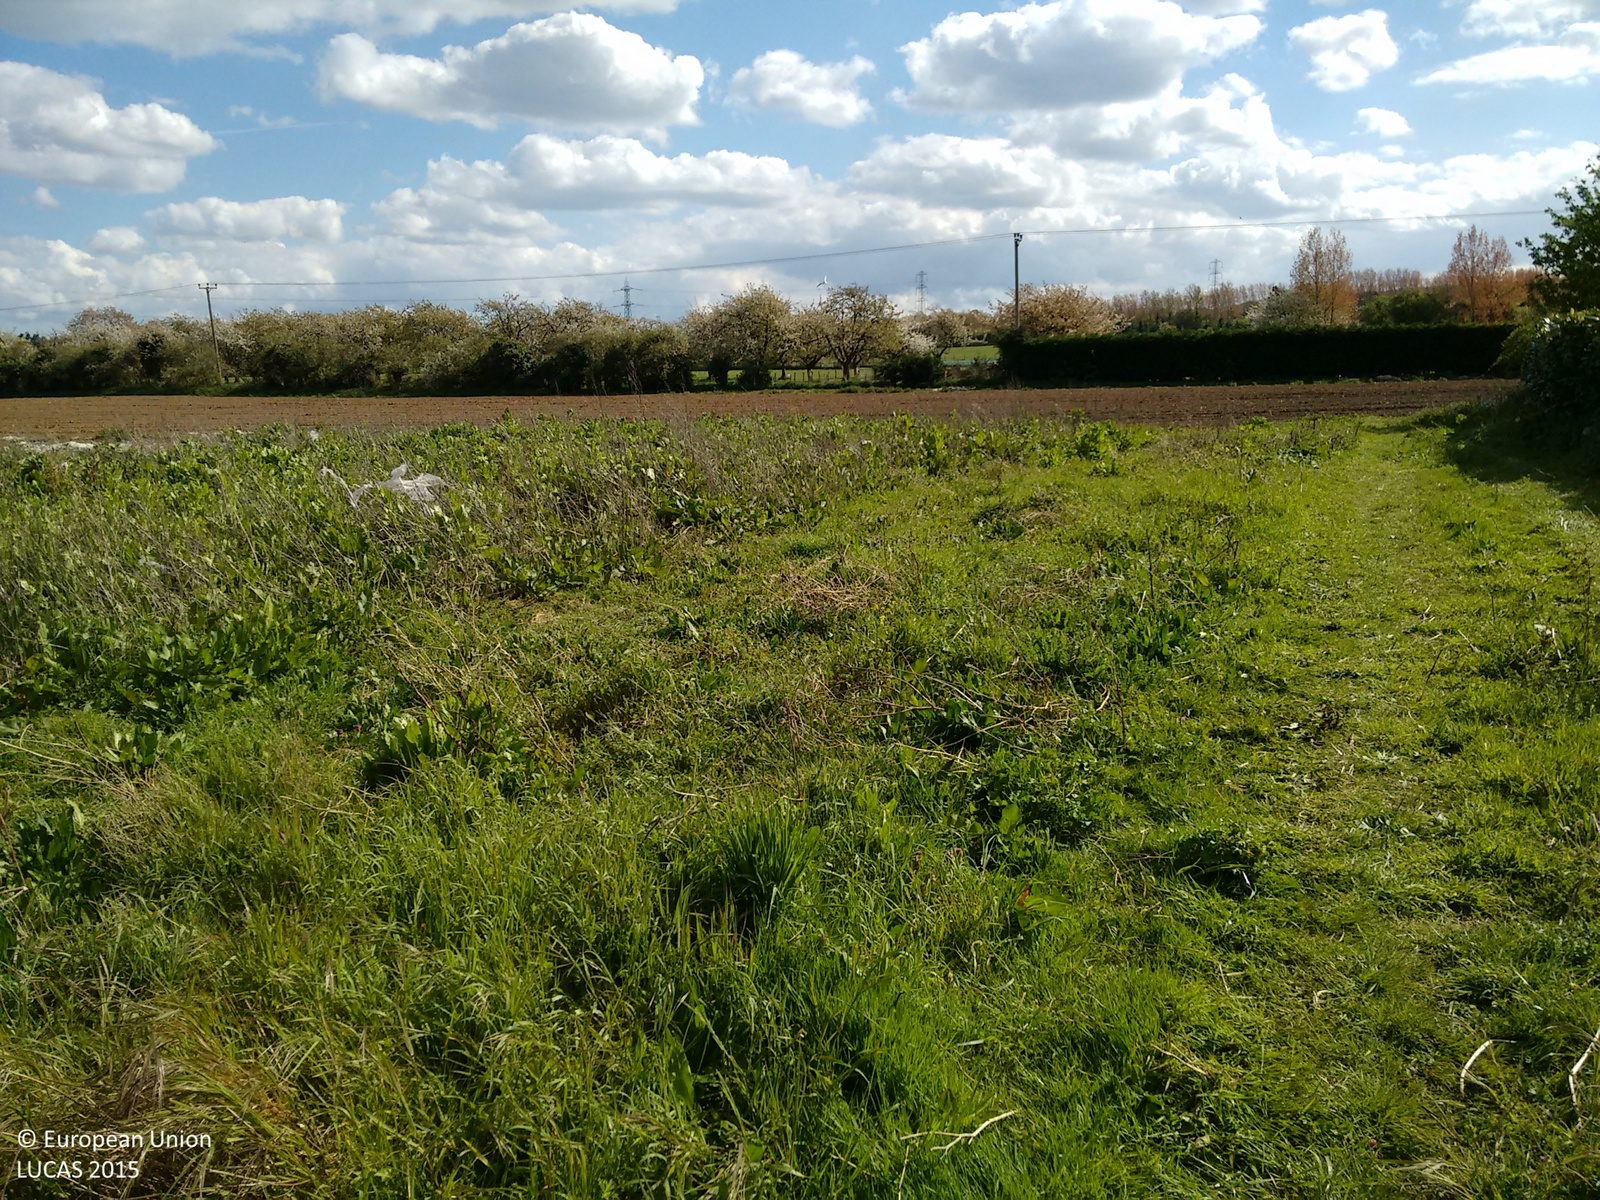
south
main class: Grassland
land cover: Grassland without tree/shrub cover
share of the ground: > 75 %
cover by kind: herbaceous plants 100 %
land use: Residential
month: April
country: GB
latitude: 51.3541
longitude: 0.6252
